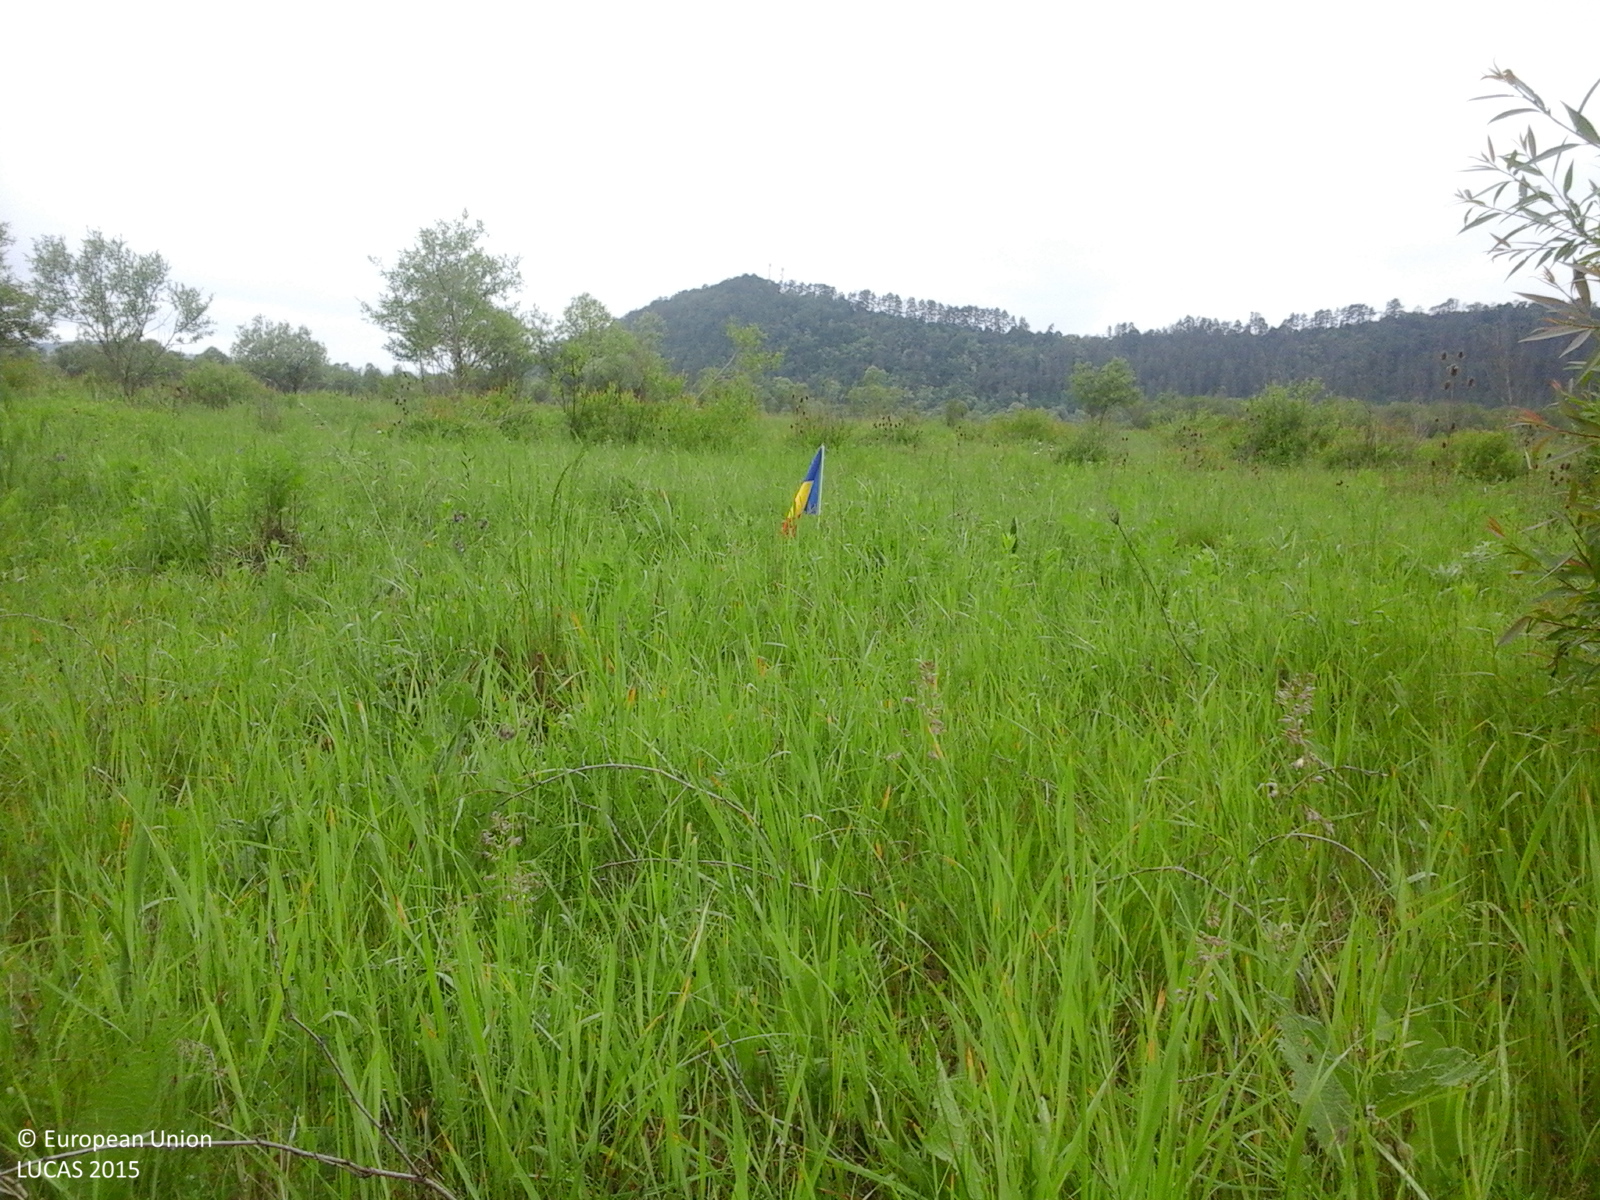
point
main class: Shrubland
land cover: Shrubland with sparse tree cover
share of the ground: > 75 %
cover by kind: herbaceous plants 85 %, shrubs 10 %, broadleaved forest trees 5 %
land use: Agriculture (excluding fallow land and kitchen gardens)
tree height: < 5 m
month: May
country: RO
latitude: 45.9309
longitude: 25.2256
